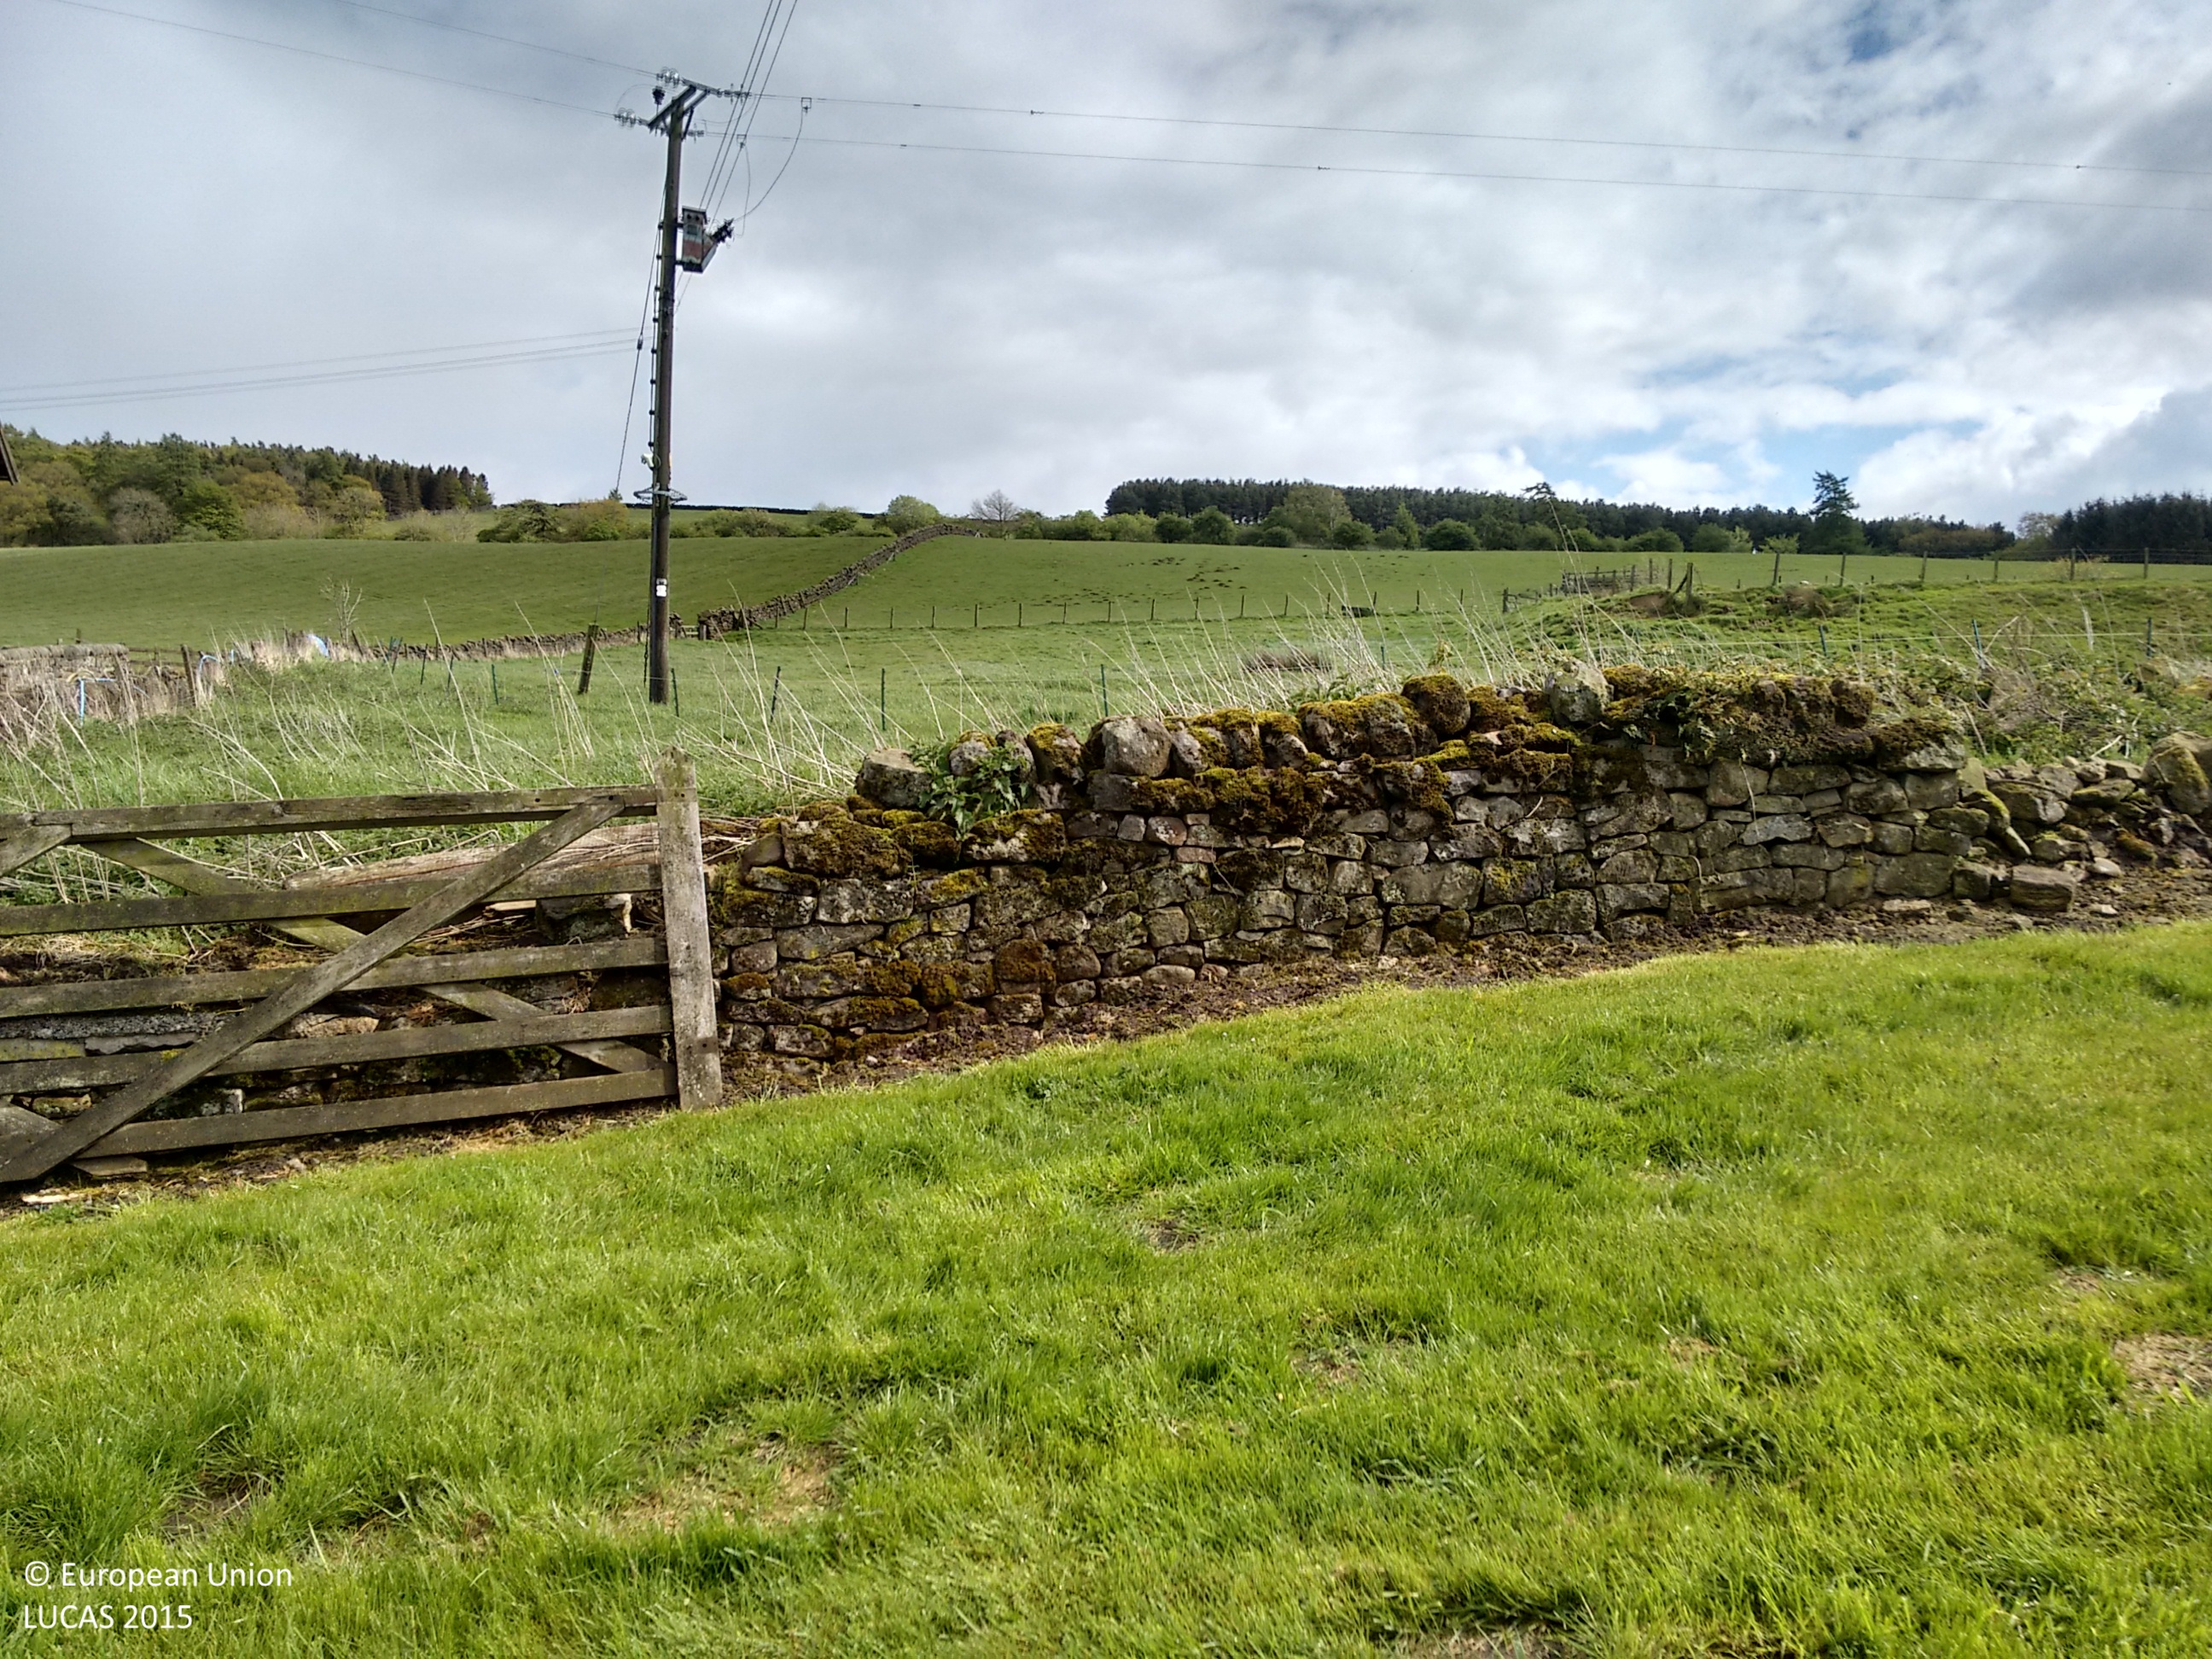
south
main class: Woodland
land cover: Pine dominated mixed woodland
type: exotic forest
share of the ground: > 75 %
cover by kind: coniferous forest trees 75 %, broadleaved forest trees 25 %
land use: Forestry
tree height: > 5 m
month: May
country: GB
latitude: 54.9841
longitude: -2.1997
